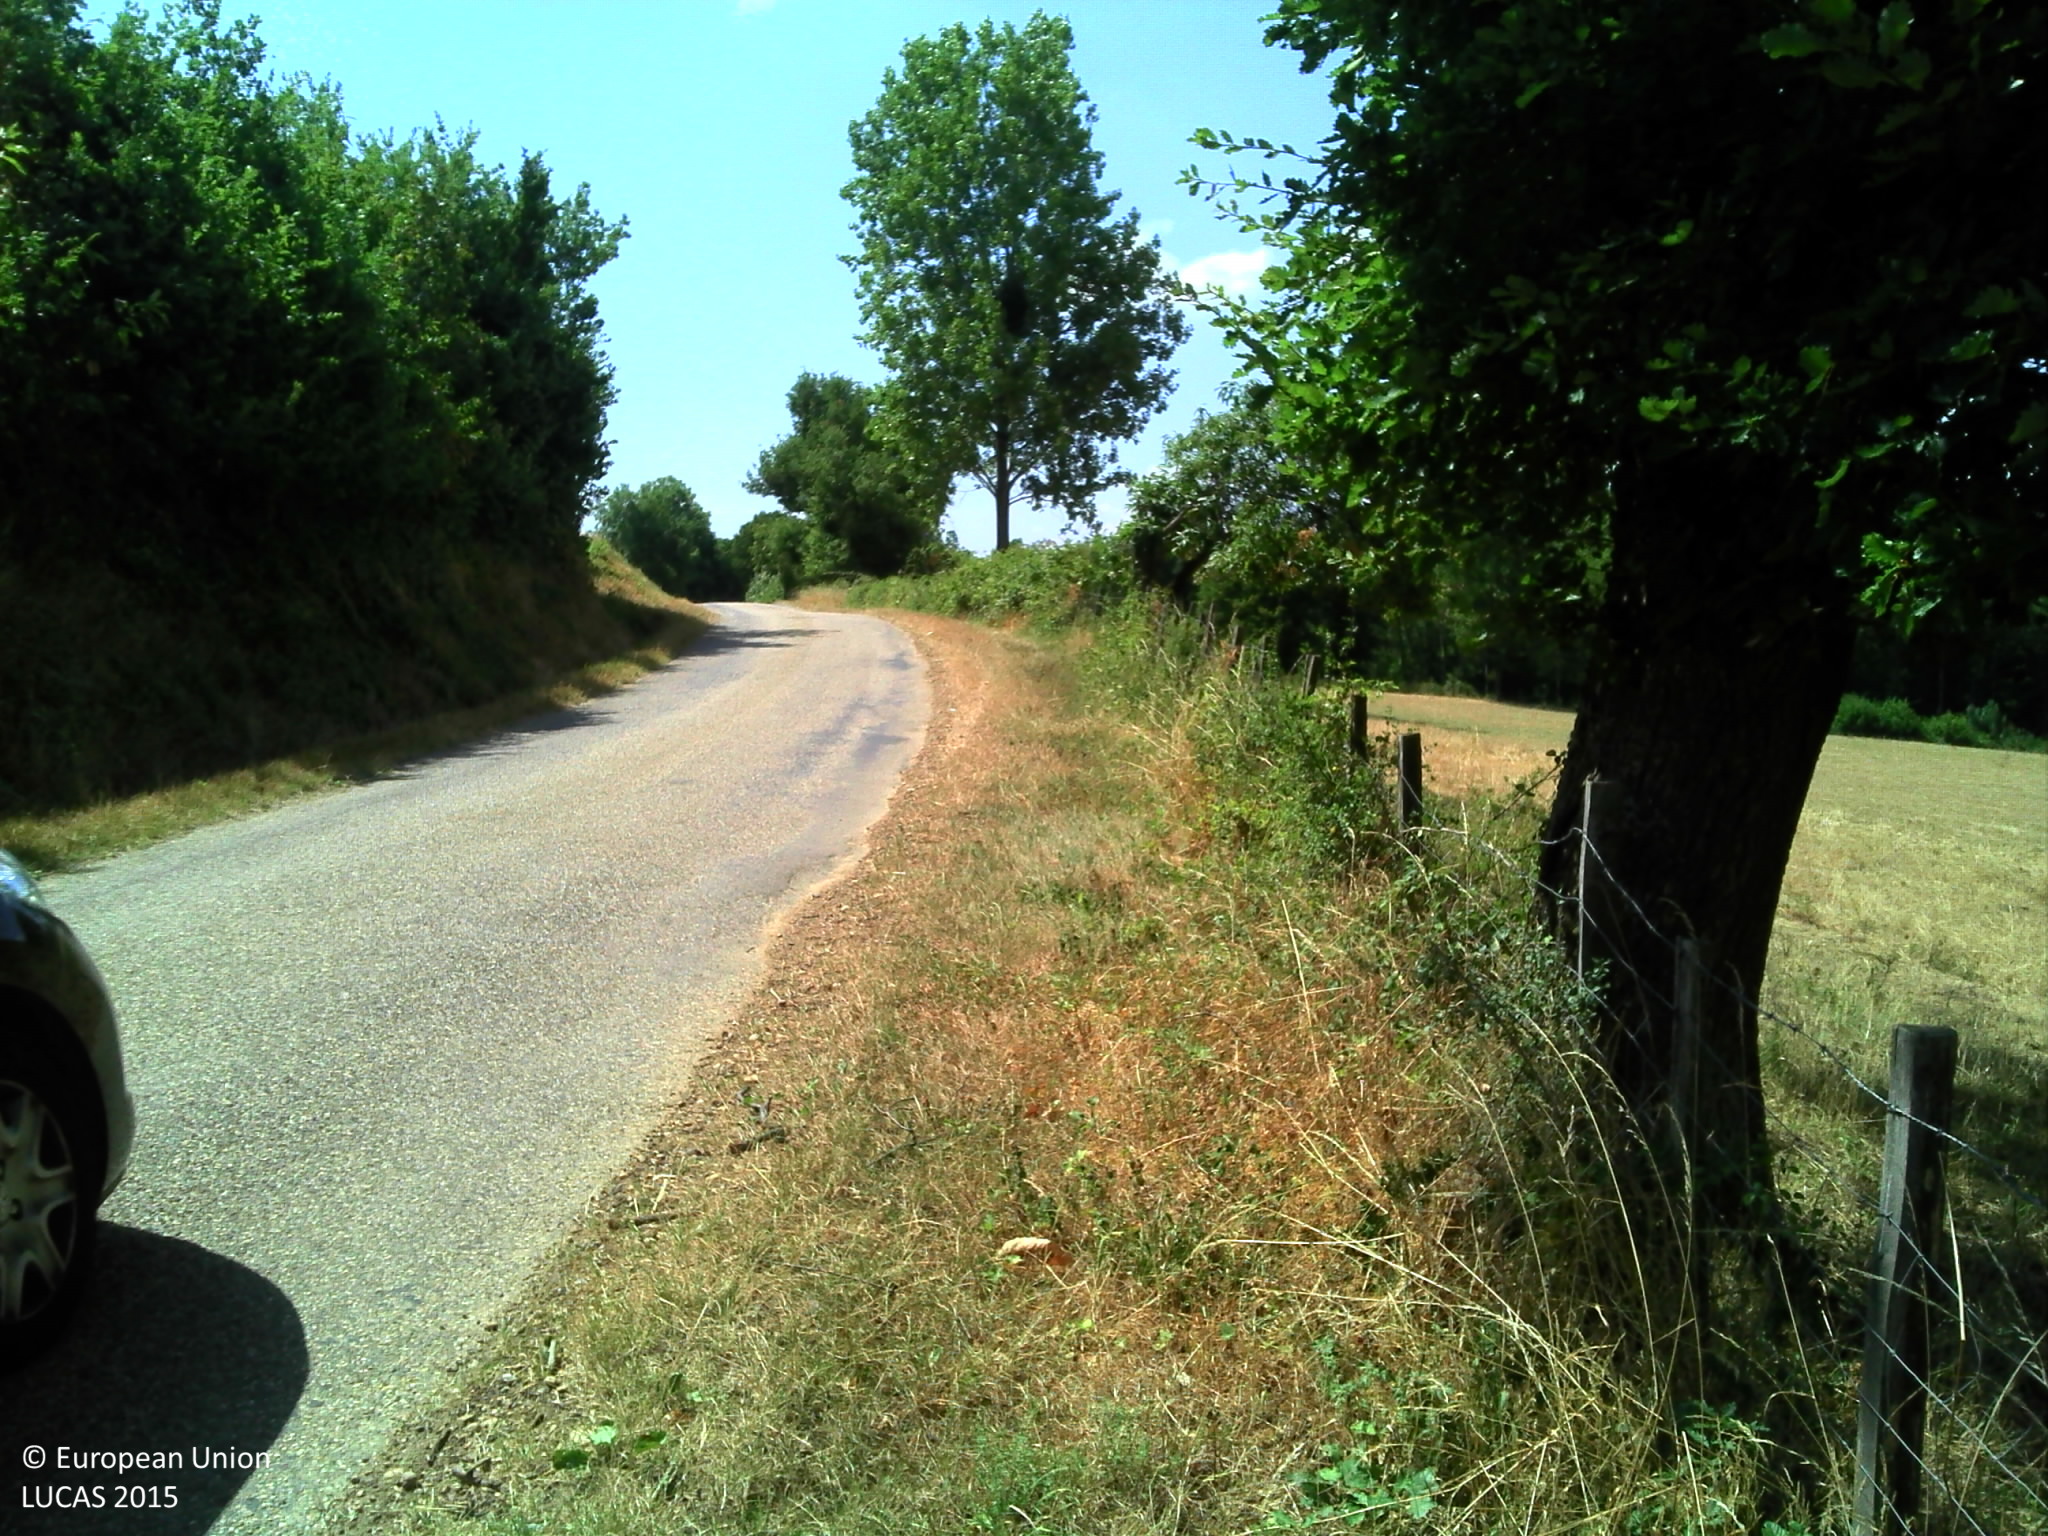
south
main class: Grassland
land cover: Grassland without tree/shrub cover
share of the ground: > 75 %
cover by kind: herbaceous plants 100 %
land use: Agriculture (excluding fallow land and kitchen gardens)
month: July
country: FR
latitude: 45.4882
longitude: 4.8735
